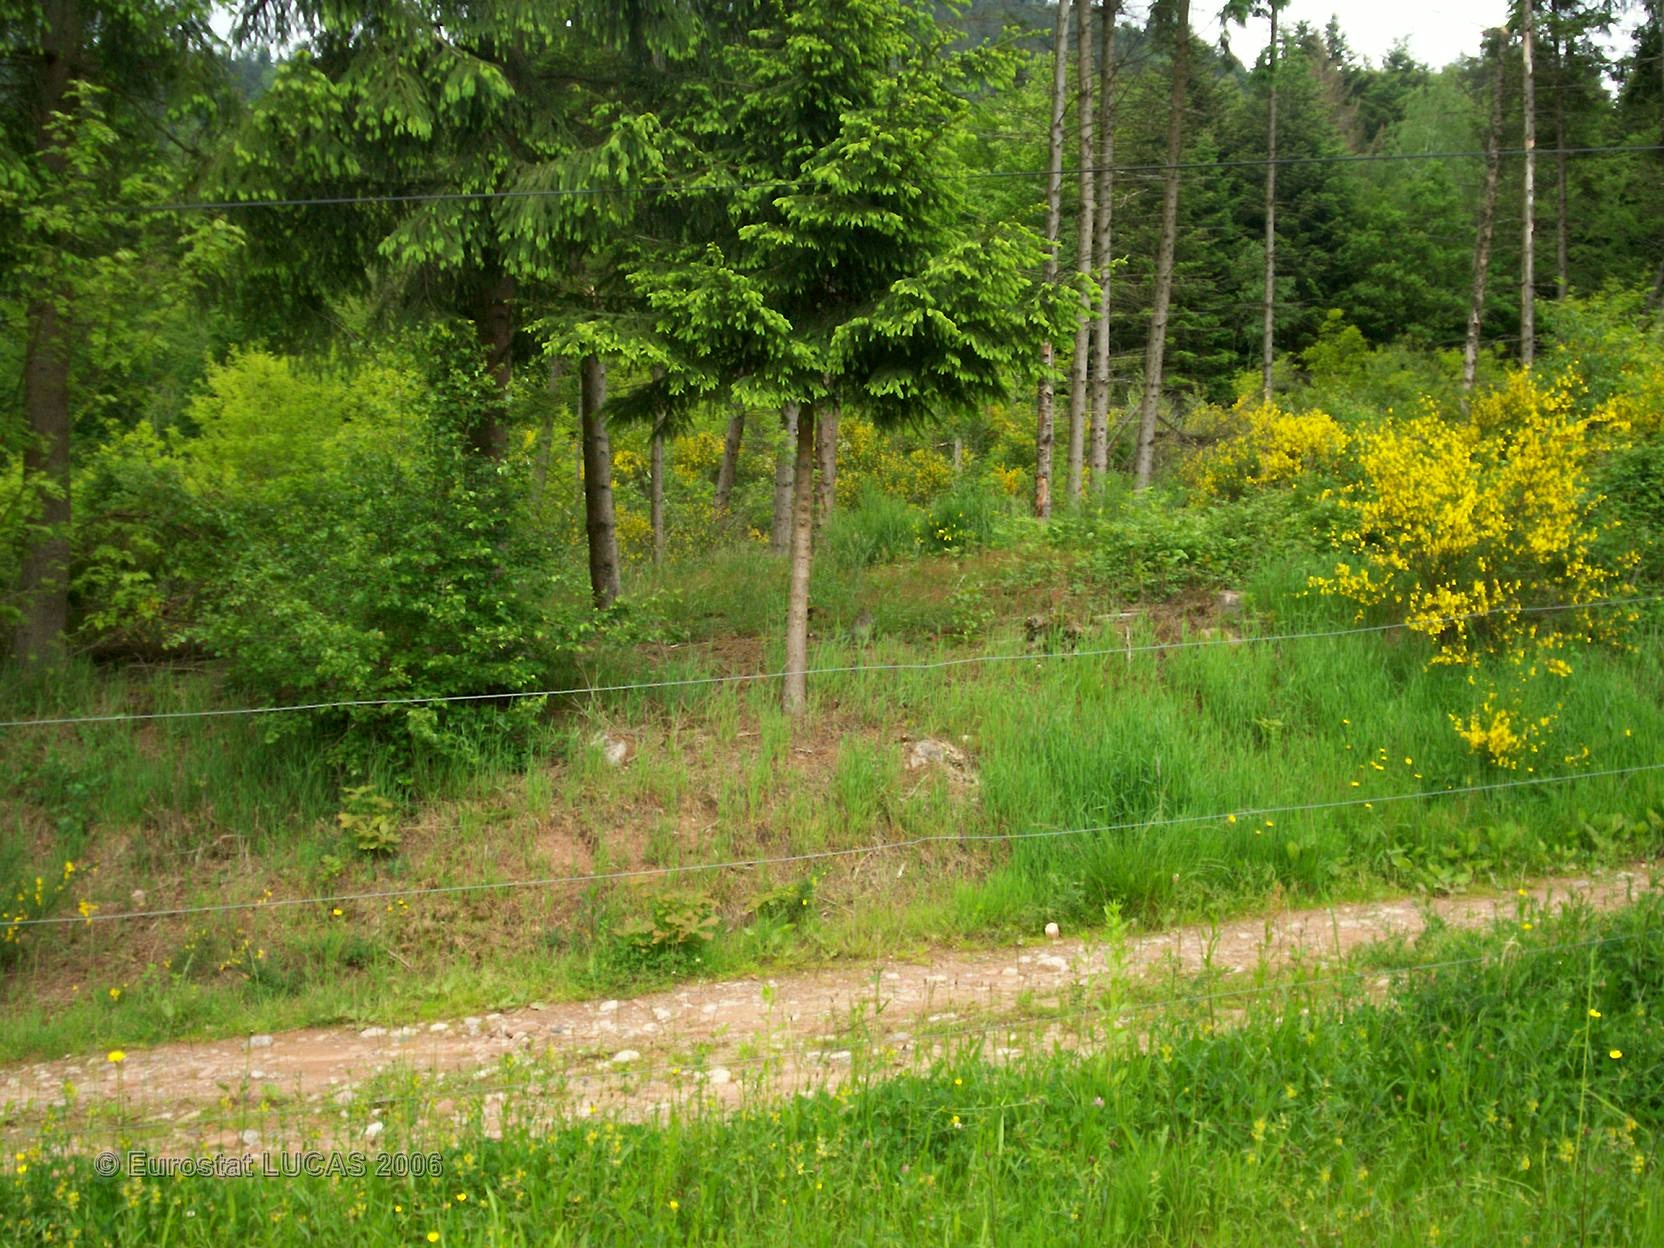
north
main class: Grassland
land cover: Grassland without tree/shrub cover
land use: Agriculture (excluding fallow land and kitchen gardens)
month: June
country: FR
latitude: 48.3978
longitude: 6.9618
